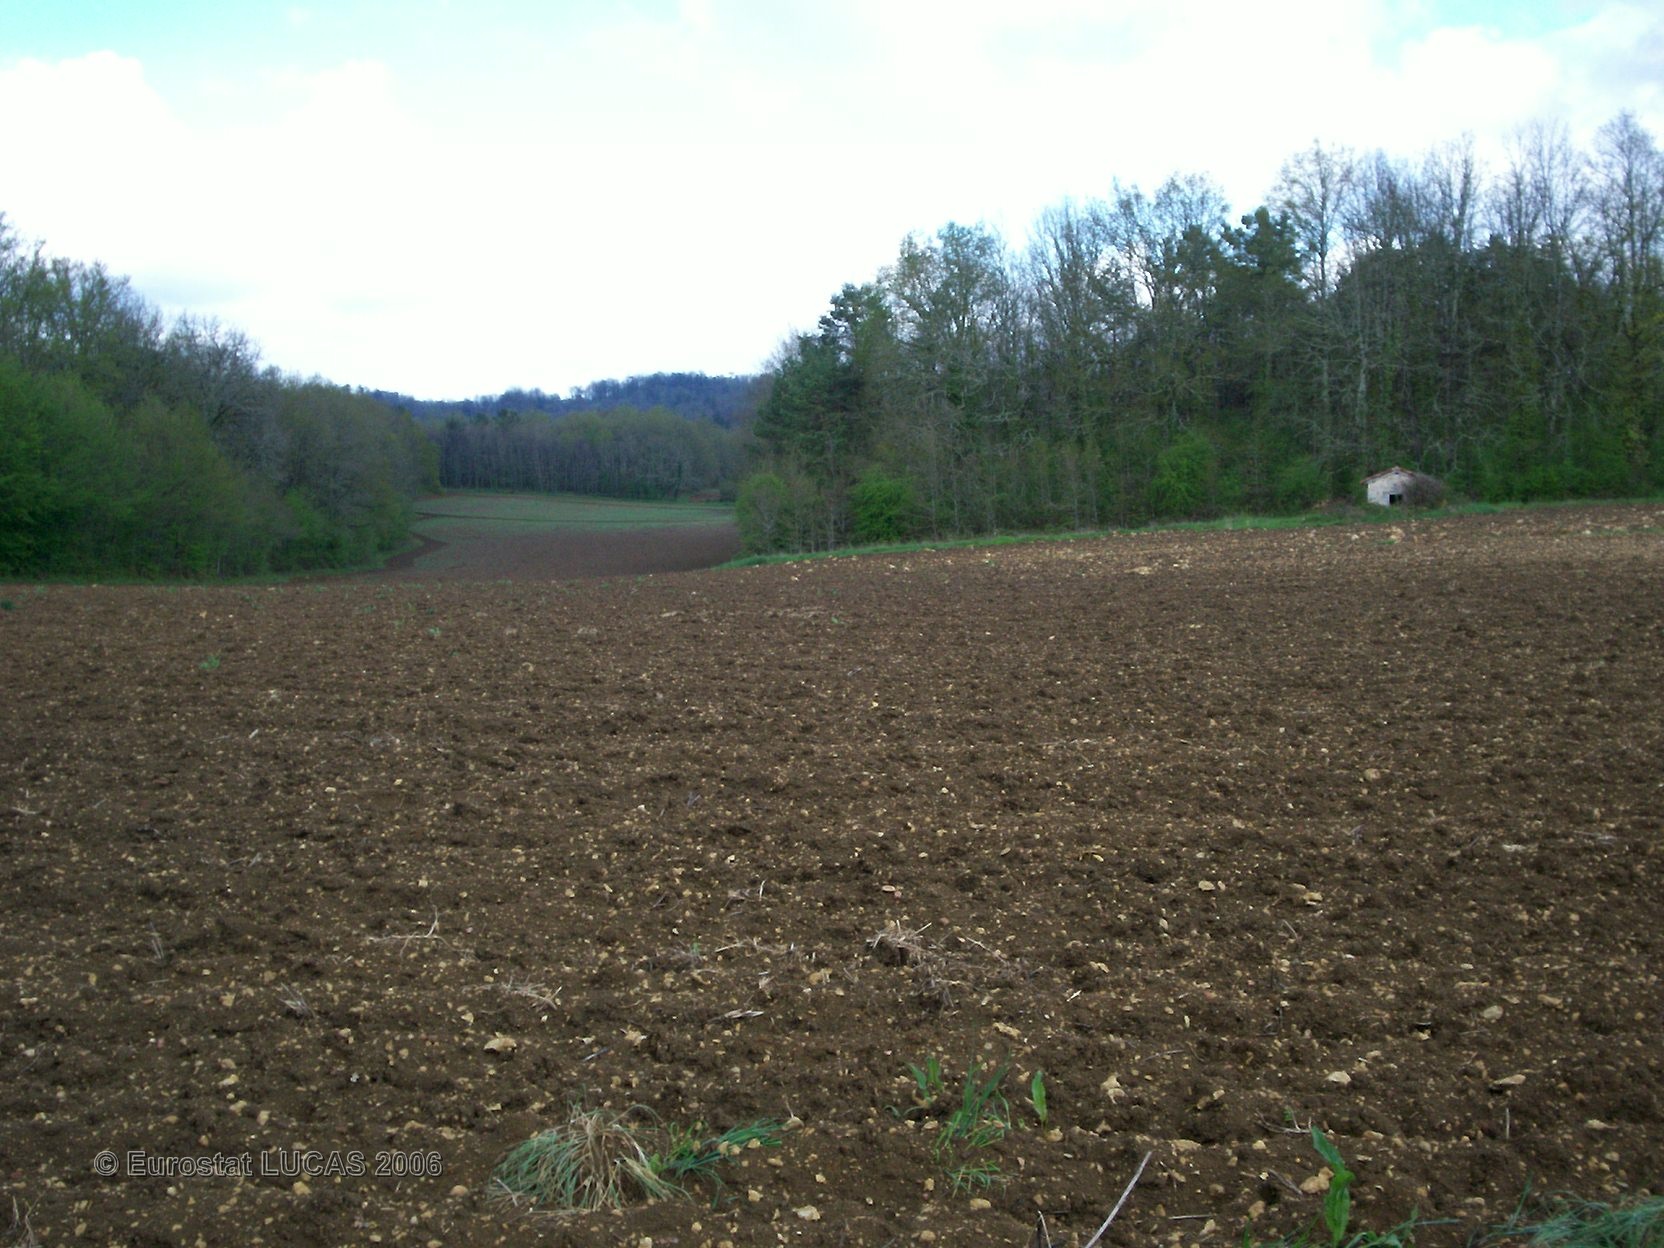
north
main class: Cropland
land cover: Maize
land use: Agriculture (excluding fallow land and kitchen gardens)
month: June
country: FR
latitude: 45.3881
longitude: 0.7550
